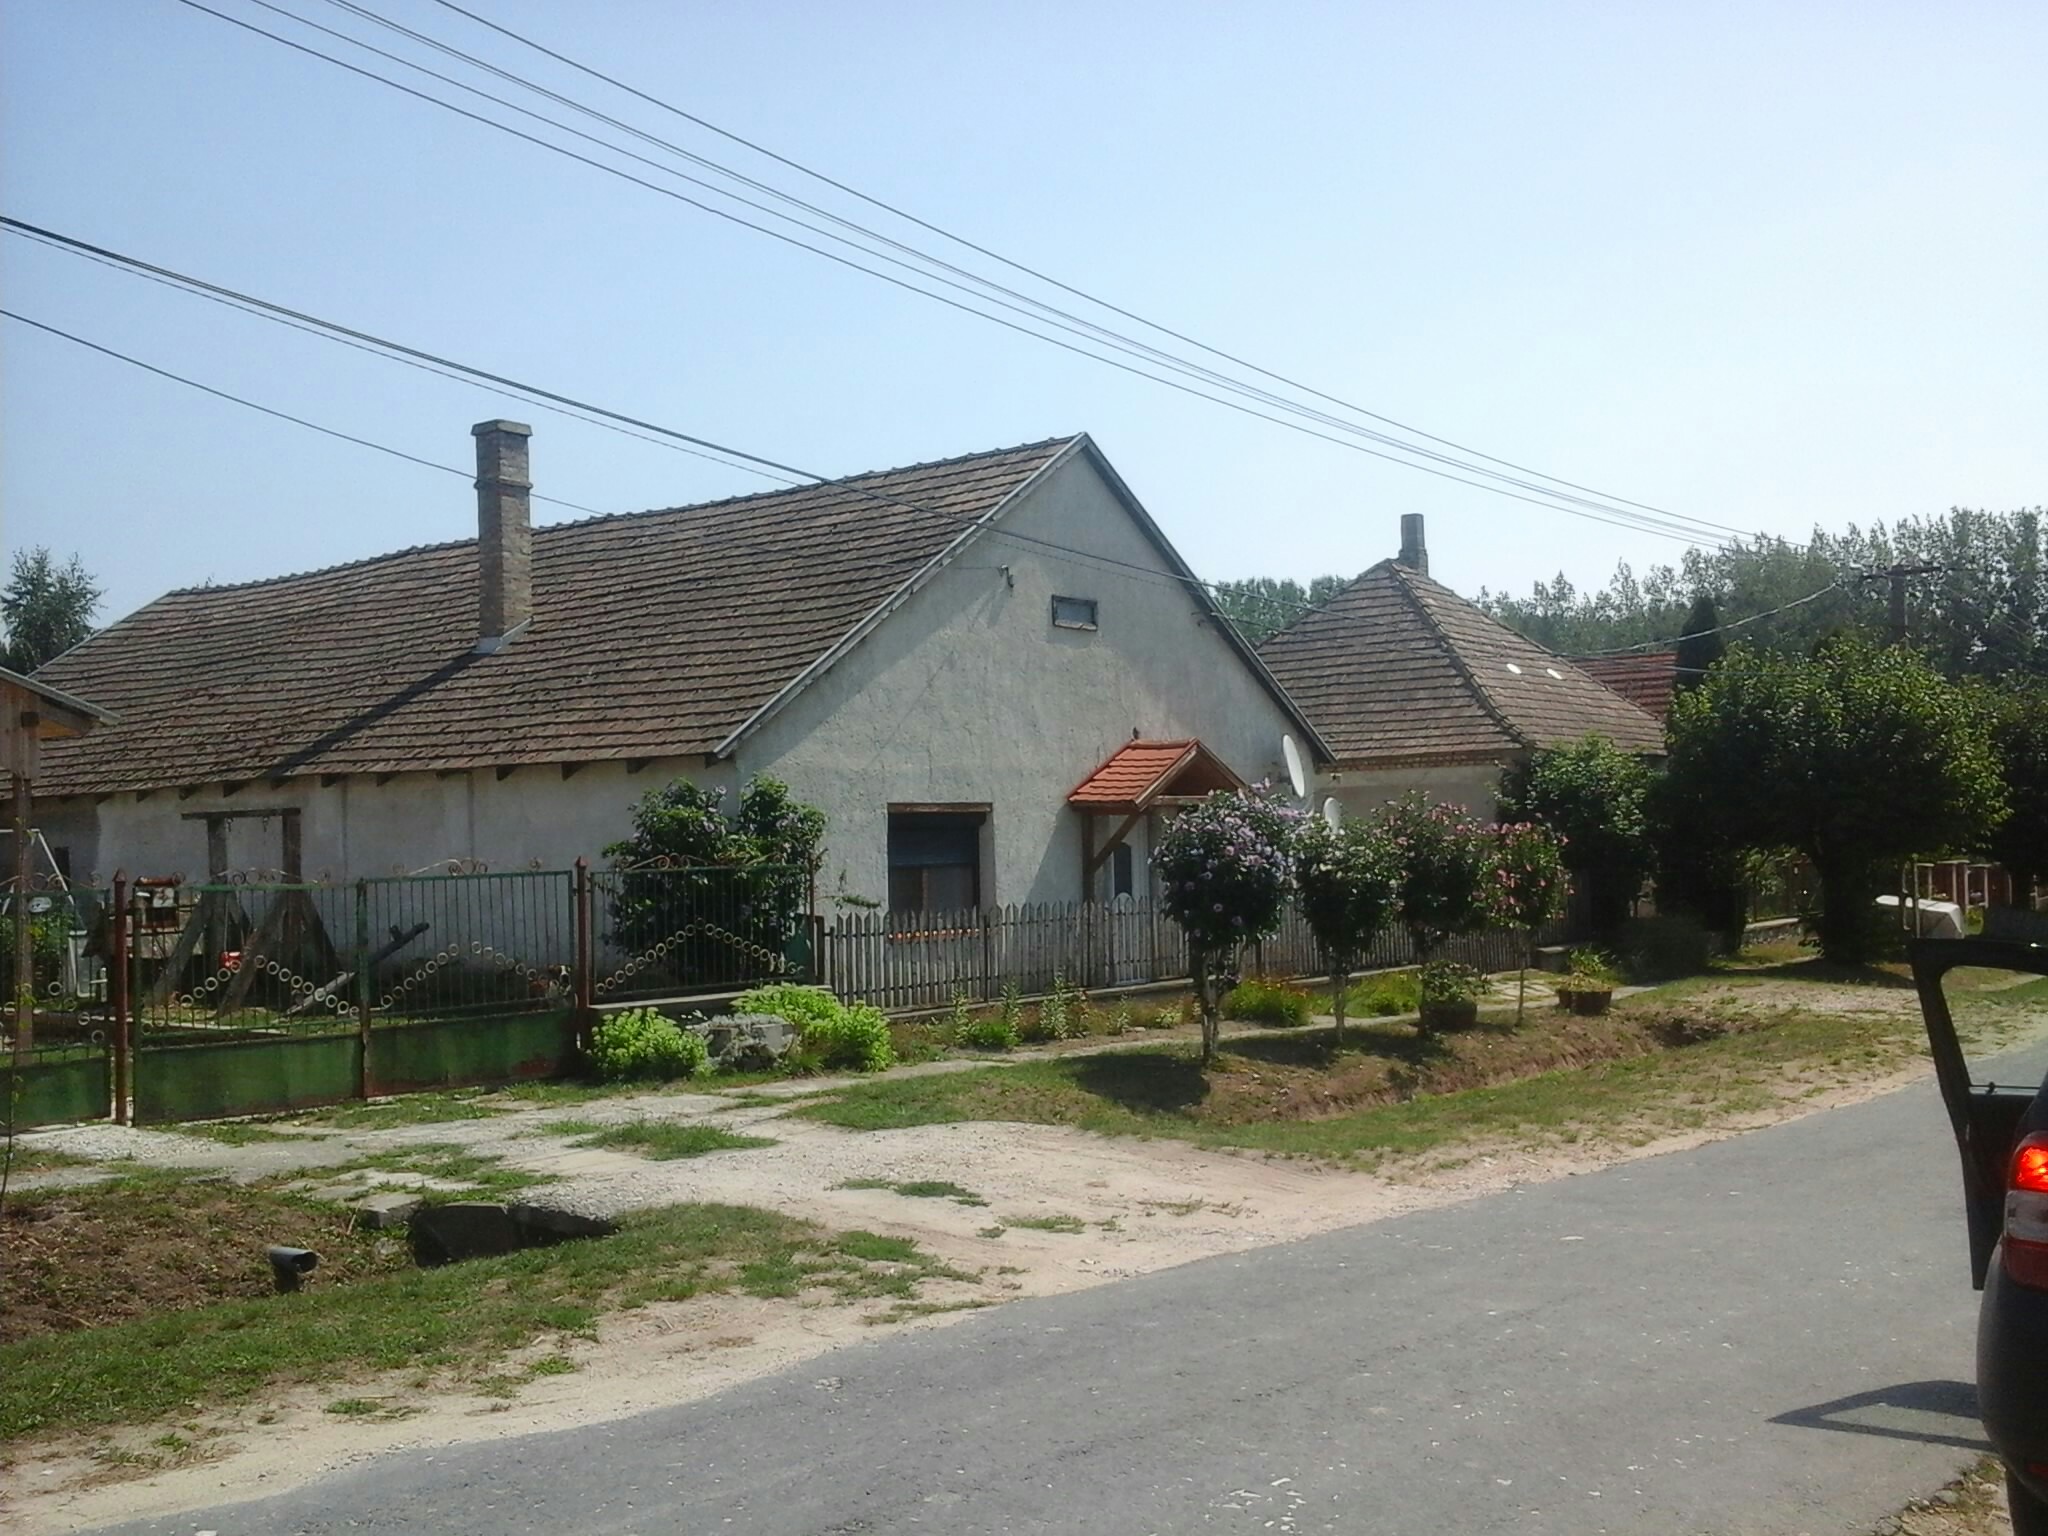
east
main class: Grassland
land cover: Grassland without tree/shrub cover
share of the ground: > 75 %
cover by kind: herbaceous plants 100 %
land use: Residential
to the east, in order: Grassland without tree/shrub cover; Artificial constructions in urban areas; Maize; Spontaneously vegetated surfaces; Broadleaved woodland; Grassland without tree/shrub cover; Maize; Other fruit trees and berries
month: August
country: HU
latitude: 47.4616
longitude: 18.0098
